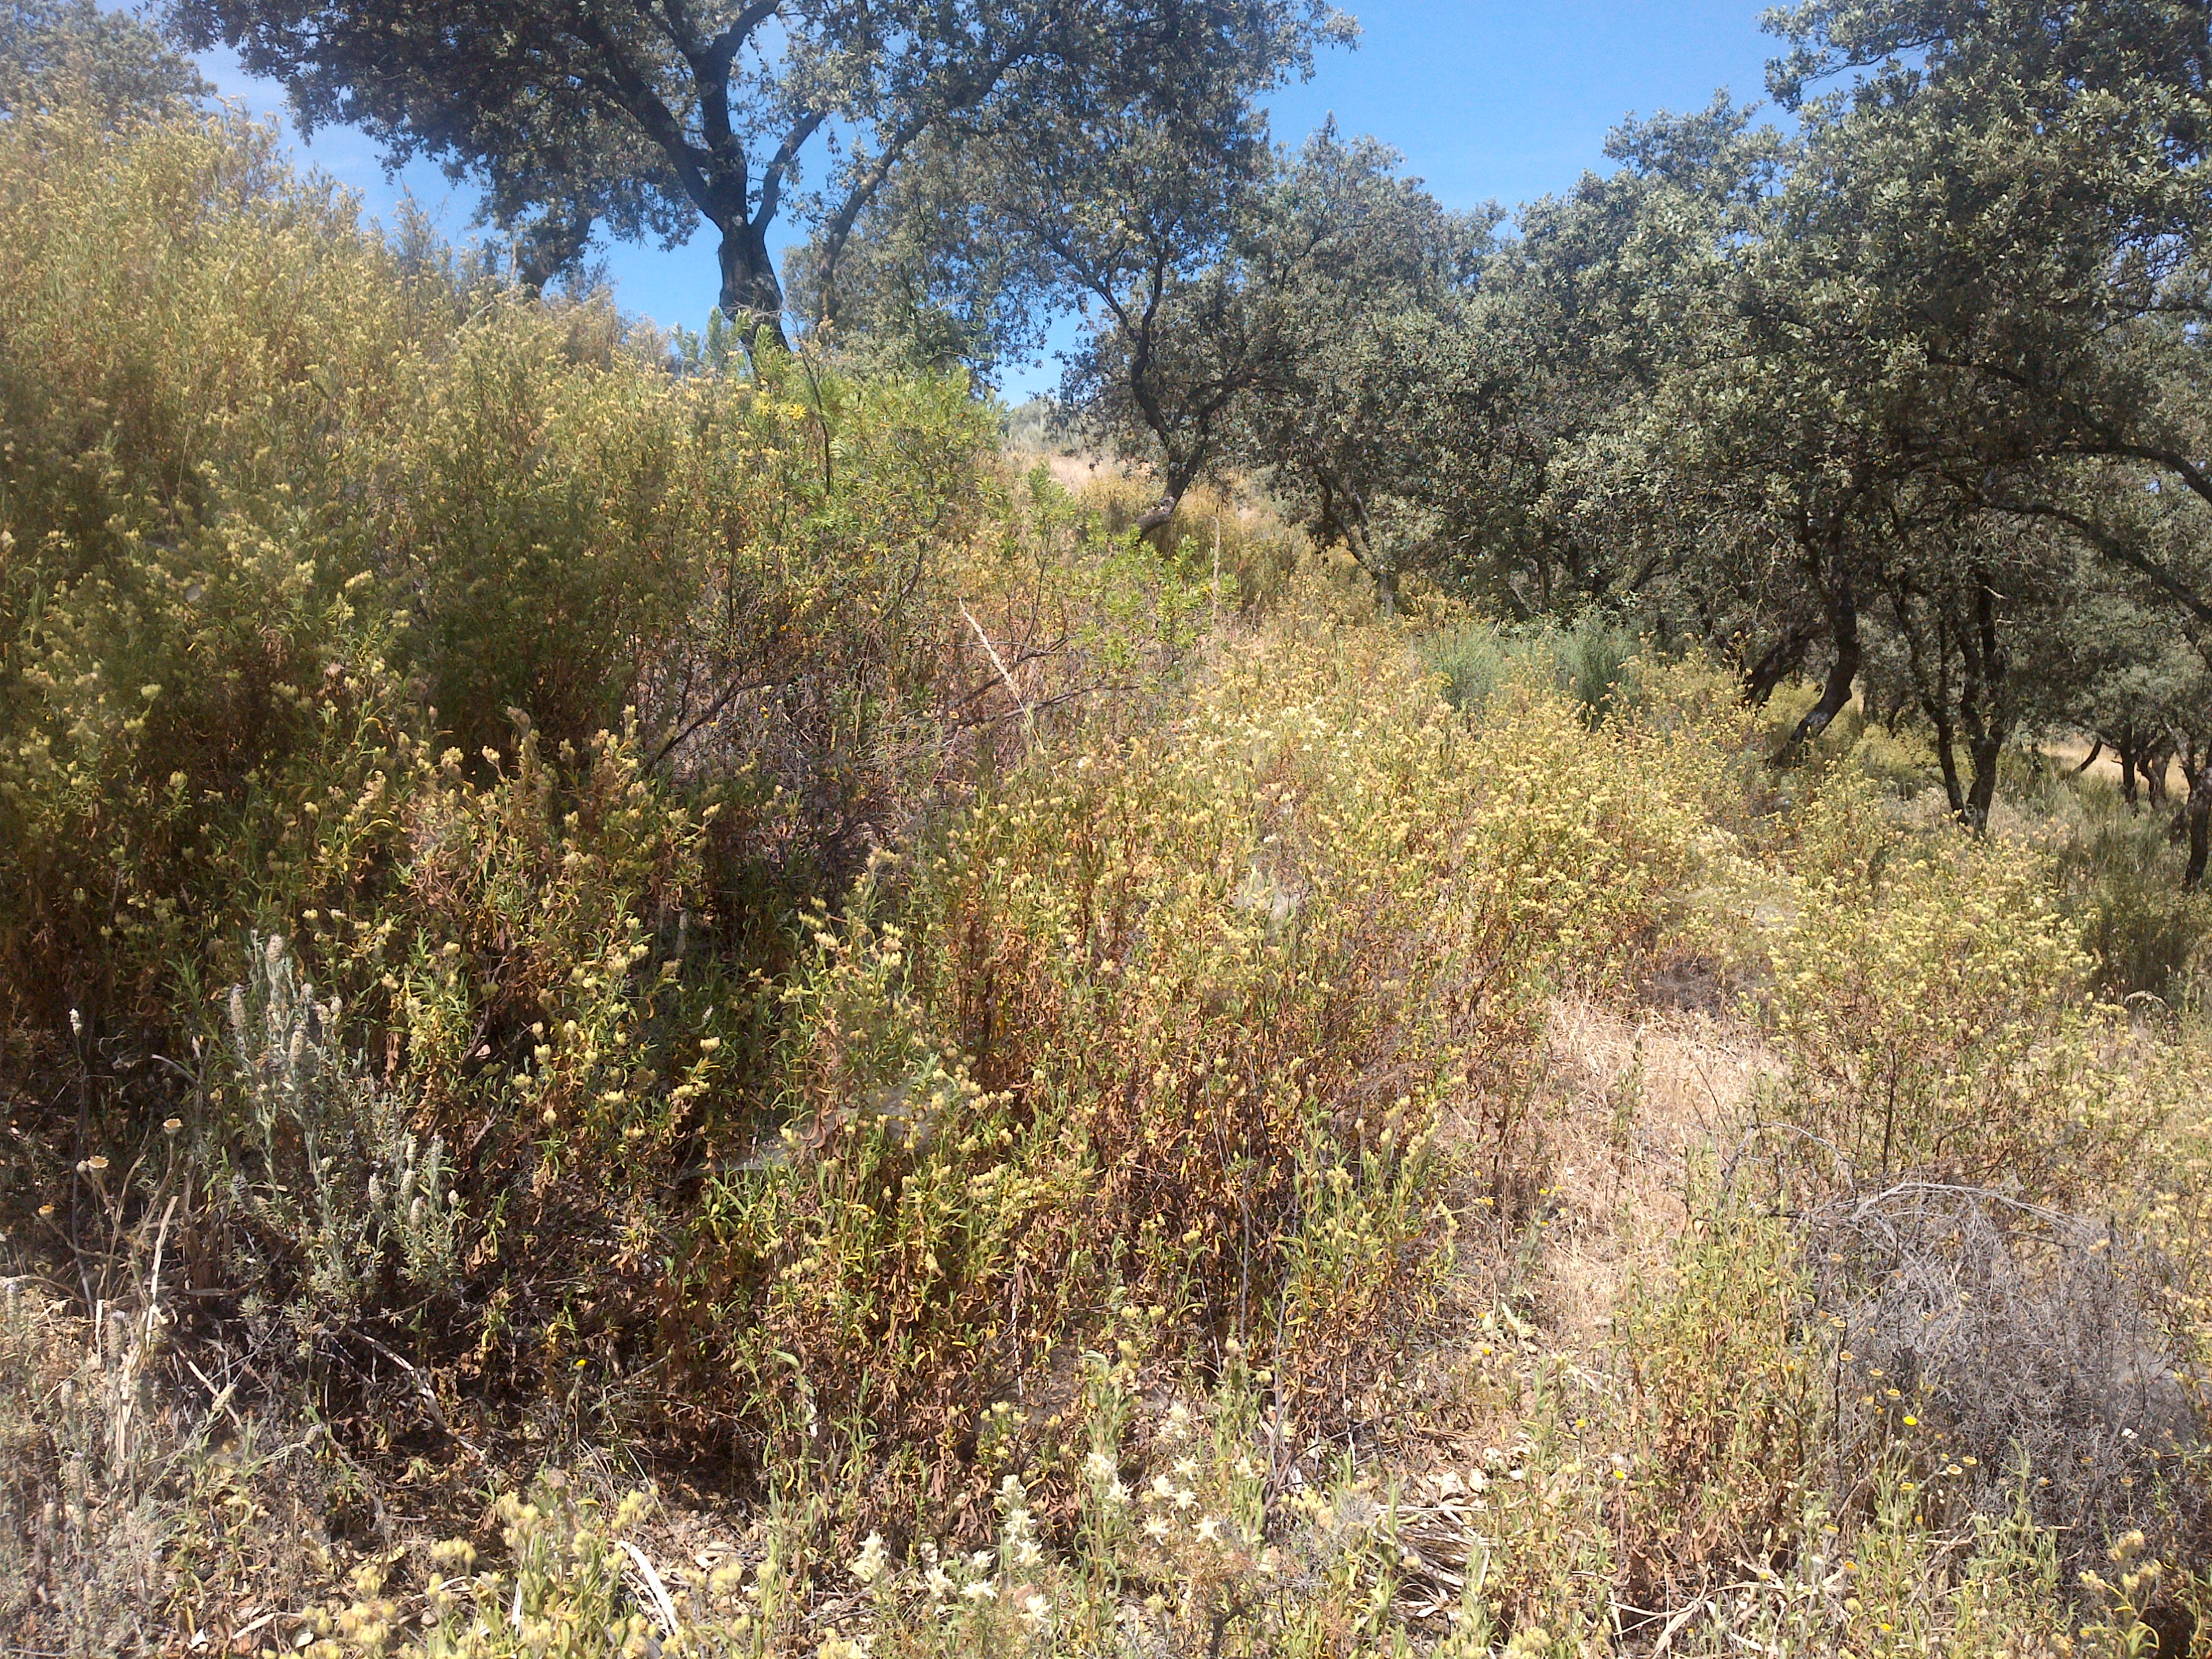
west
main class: Woodland
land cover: Broadleaved woodland
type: broadleaved evergreen forest
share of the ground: 10 - 25 %
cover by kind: shrubs 60 %, broadleaved forest trees 20 %, herbaceous plants 20 %
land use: Semi-natural and natural areas not in use
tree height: < 5 m
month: May
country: ES
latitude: 38.0212
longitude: -4.5373
